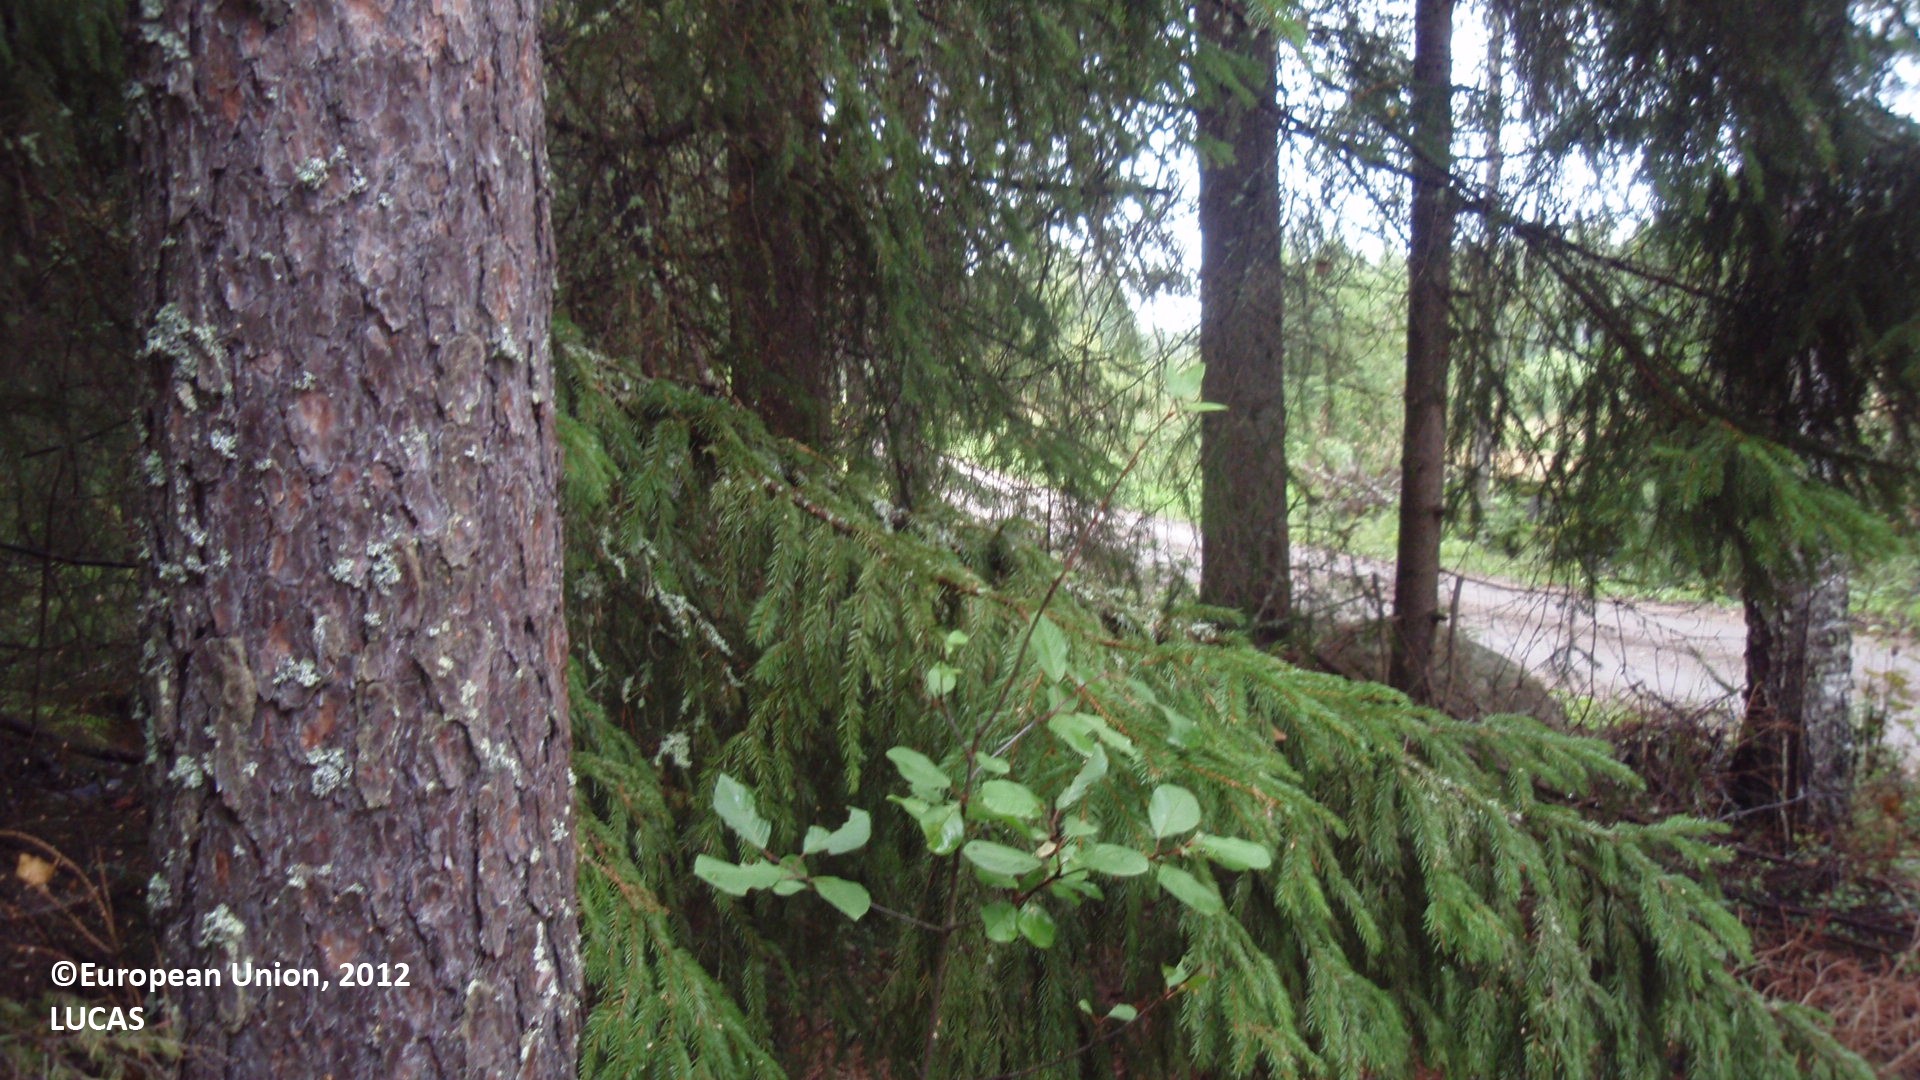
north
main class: Woodland
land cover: Other coniferous woodland
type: boreal forest
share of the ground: 50 - 75 %
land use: Forestry
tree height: > 5 m
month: August
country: FI
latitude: 61.2720
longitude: 26.9288
